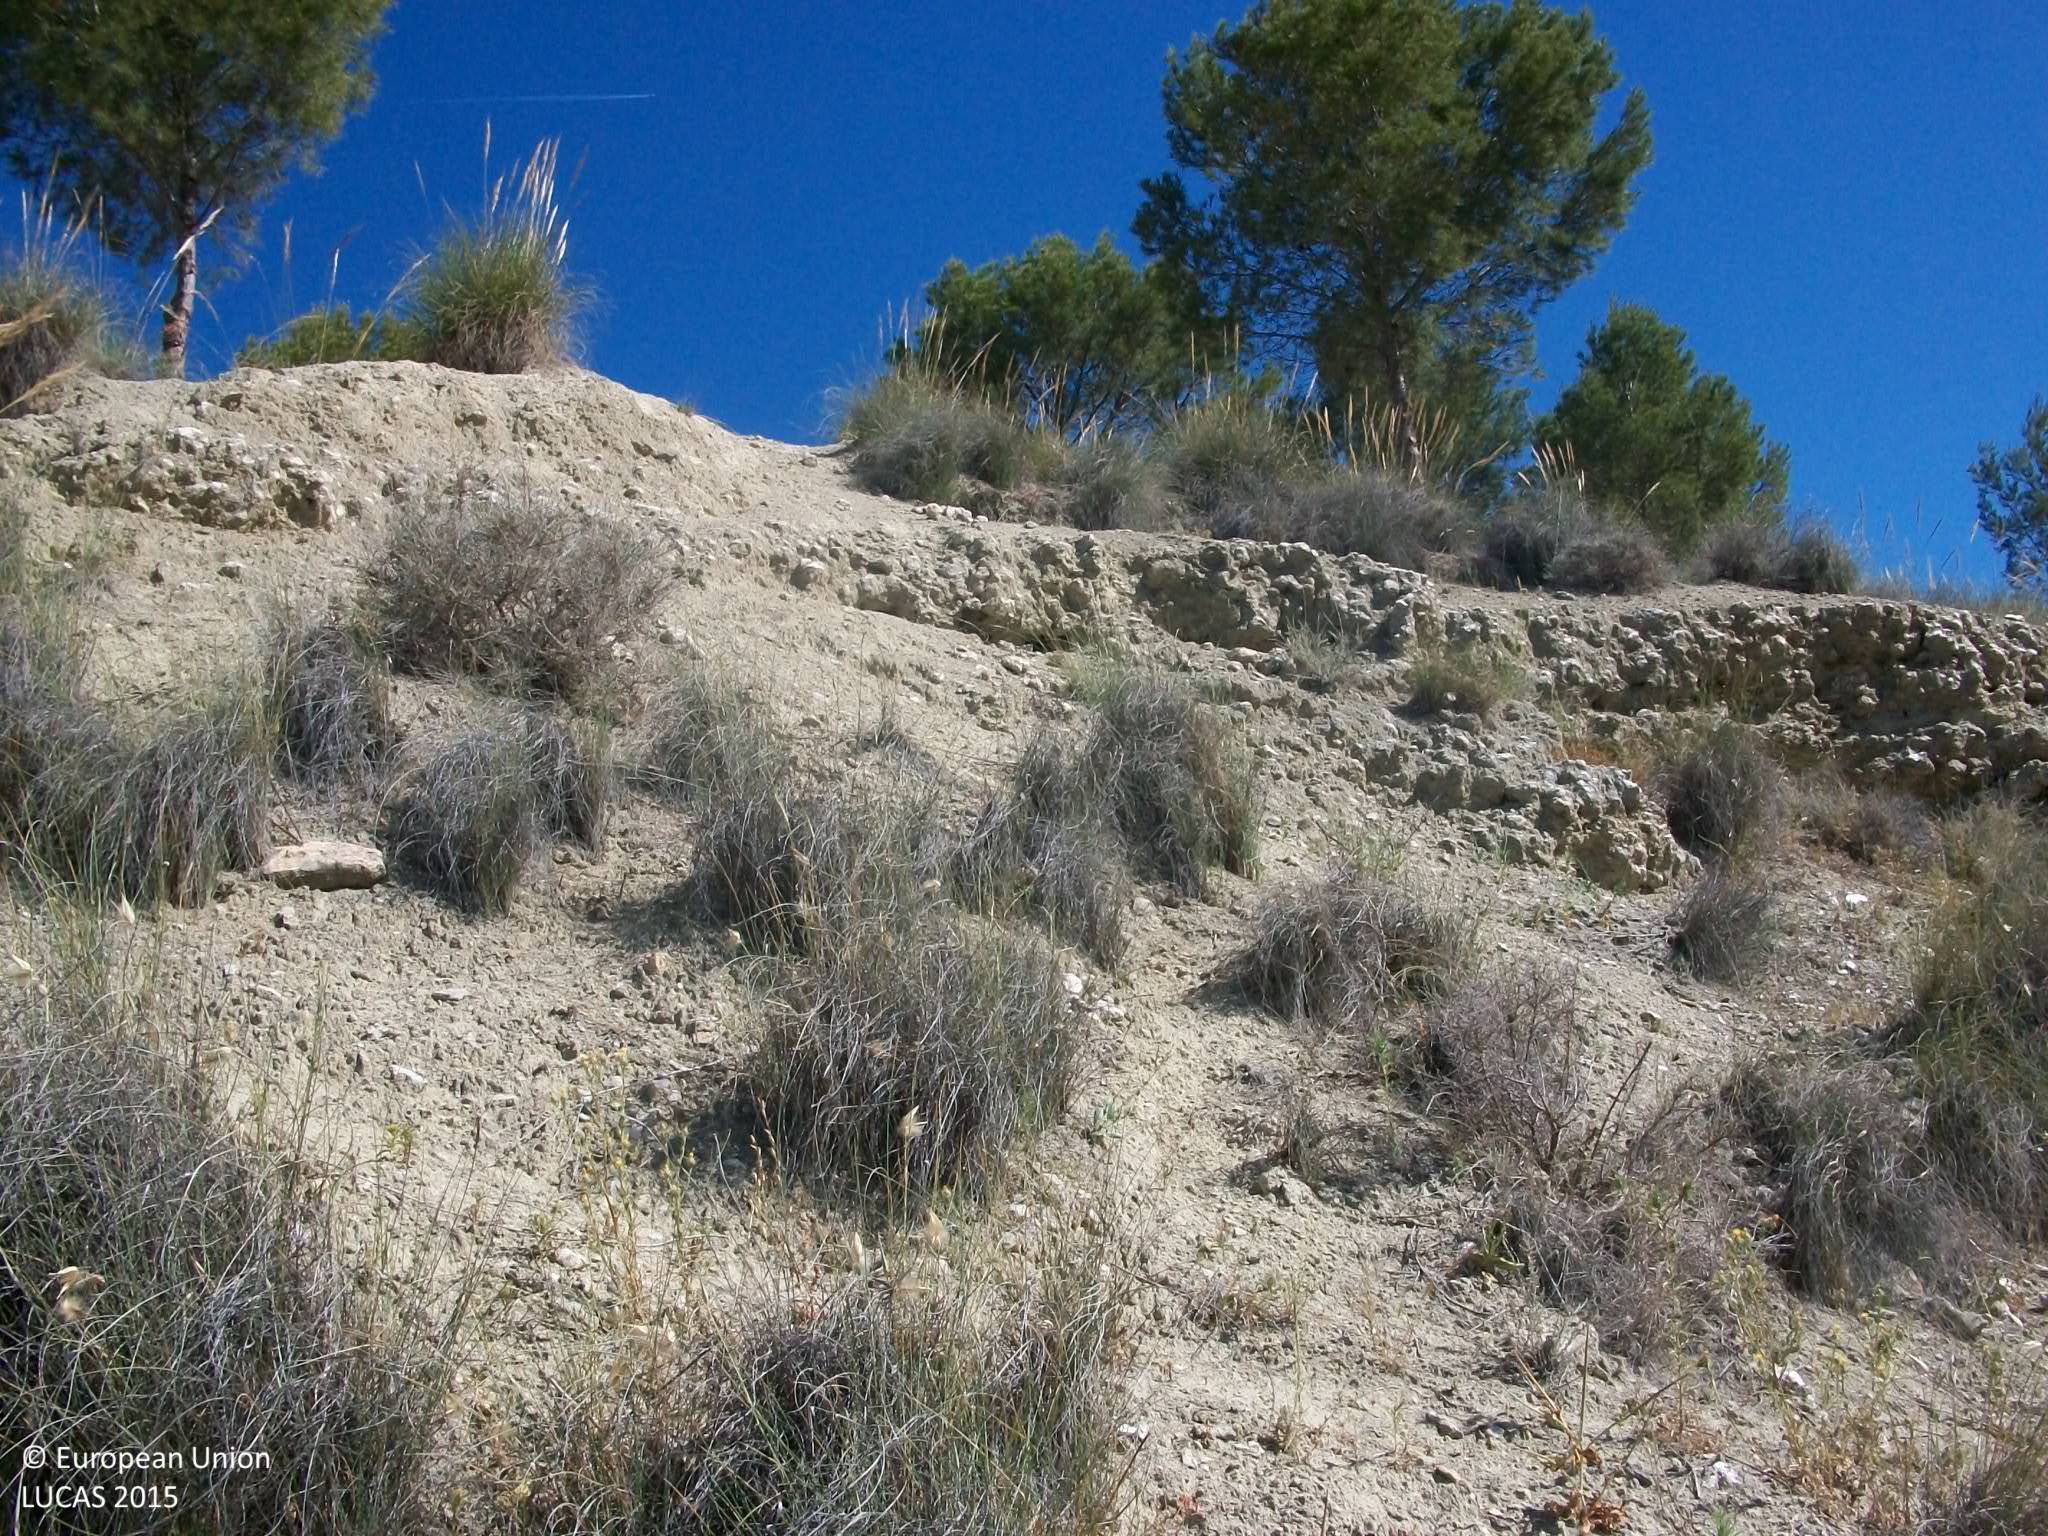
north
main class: Grassland
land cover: Grassland without tree/shrub cover
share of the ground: > 75 %
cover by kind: herbaceous plants 80 %, consolidated bare surface 20 %
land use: Semi-natural and natural areas not in use
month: May
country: ES
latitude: 39.8729
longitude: -3.6741
